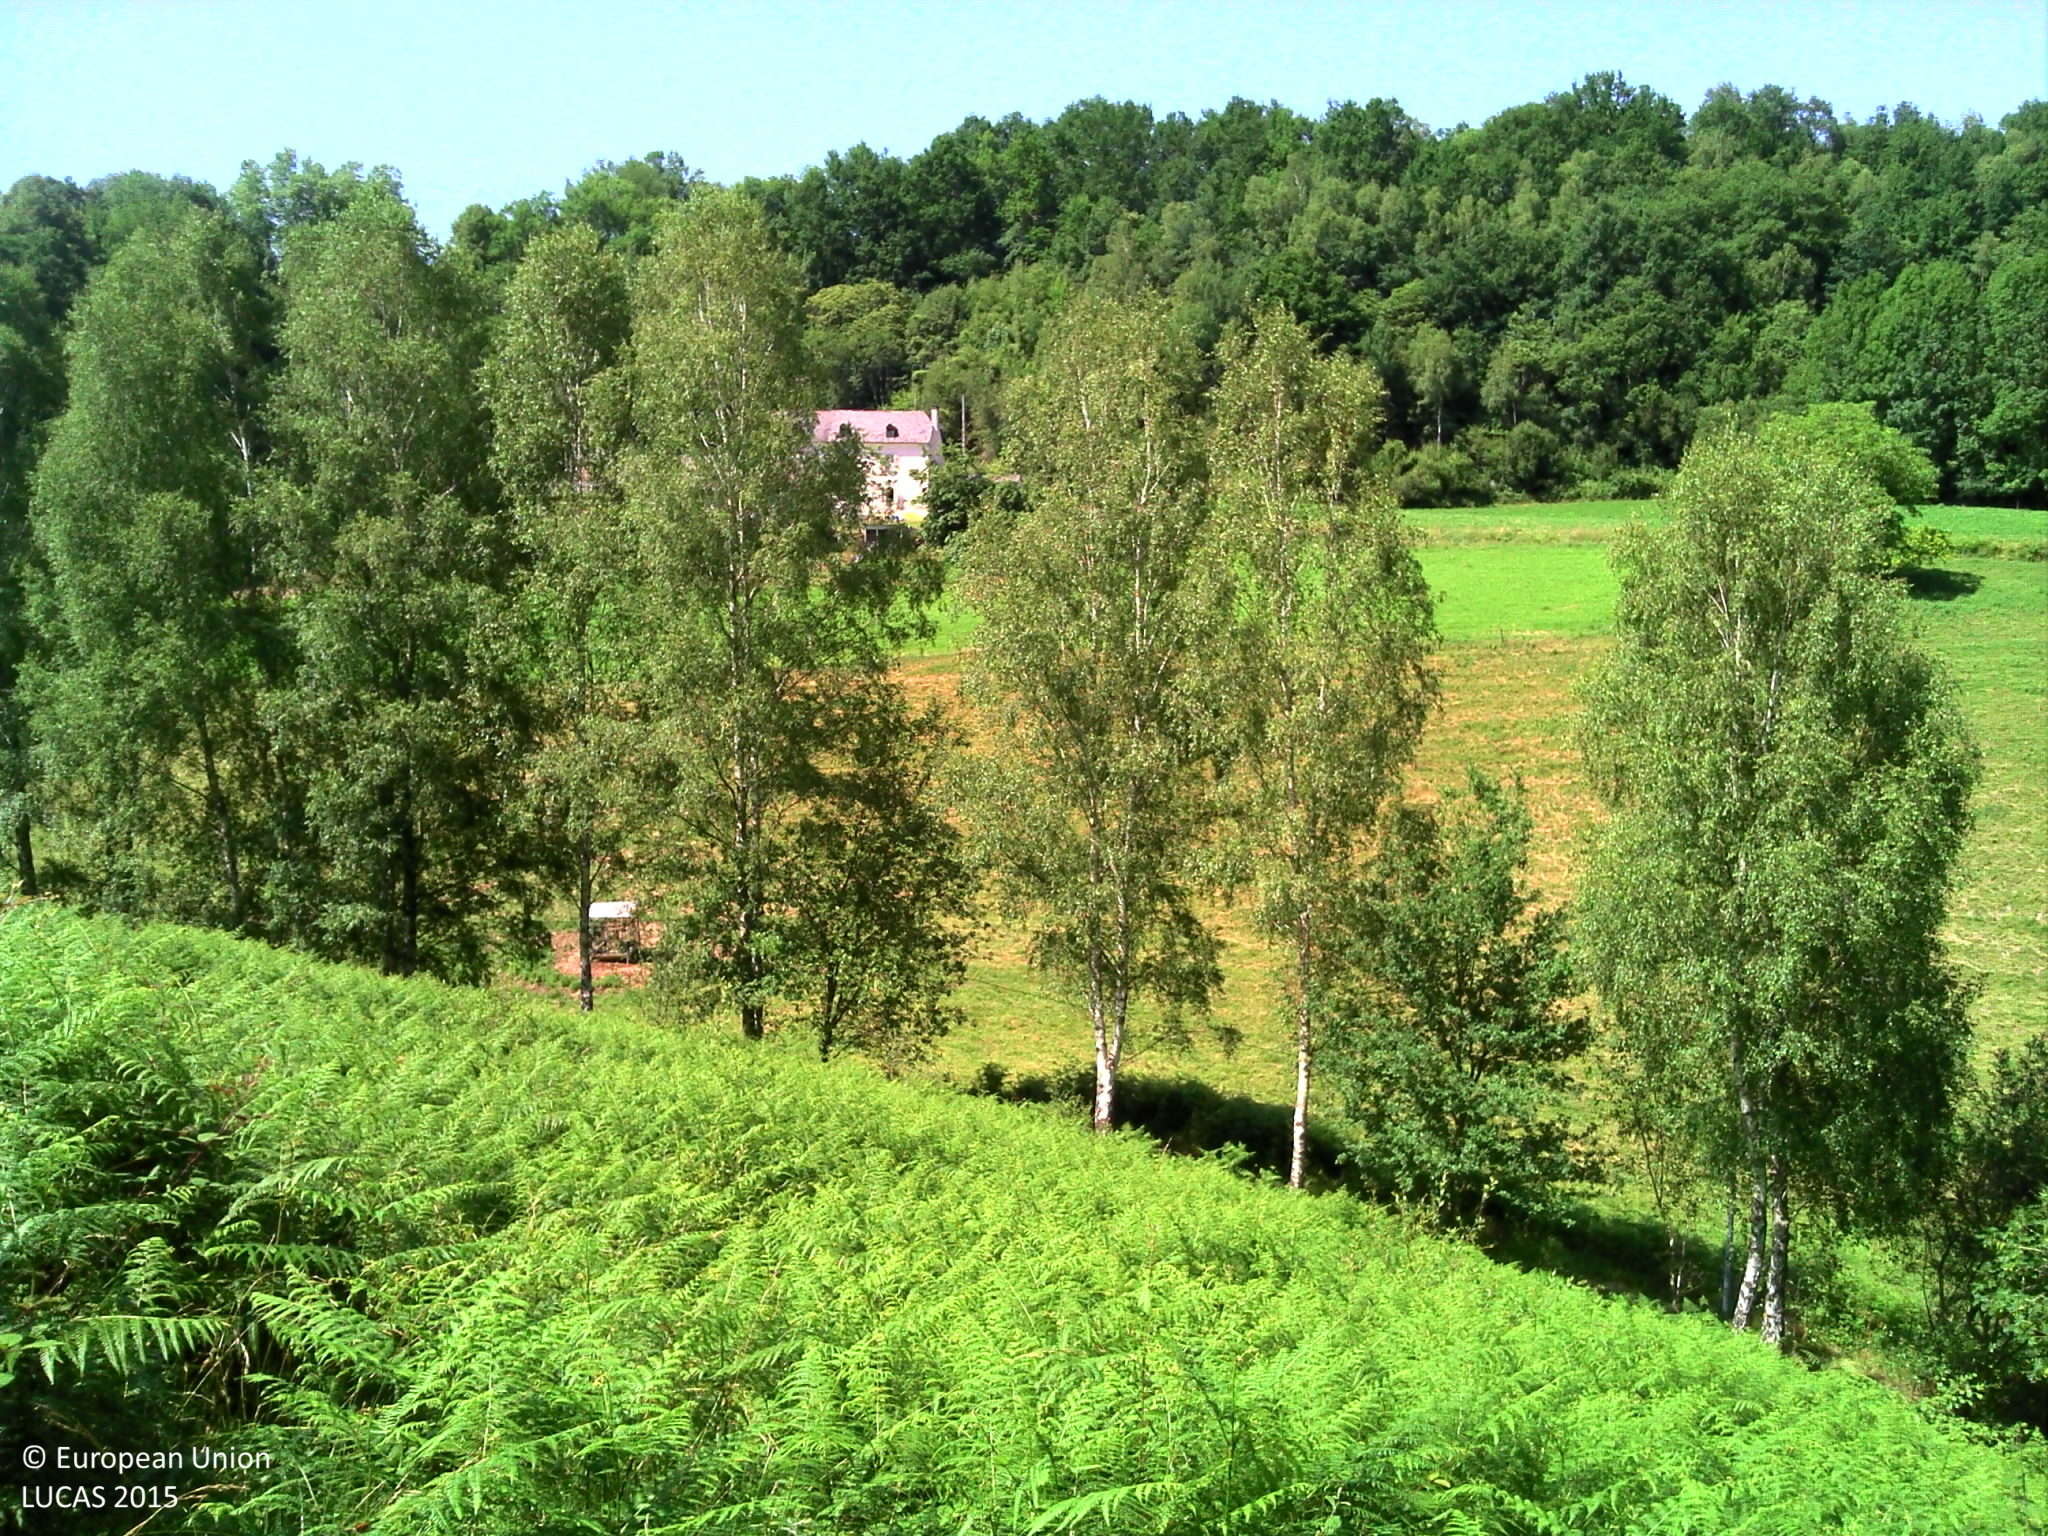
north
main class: Shrubland
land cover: Shrubland with sparse tree cover
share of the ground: > 75 %
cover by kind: herbaceous plants 85 %, shrubs 10 %, broadleaved forest trees 5 %
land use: Semi-natural and natural areas not in use
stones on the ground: < 10 %
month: June
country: FR
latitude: 43.1074
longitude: -0.1414
